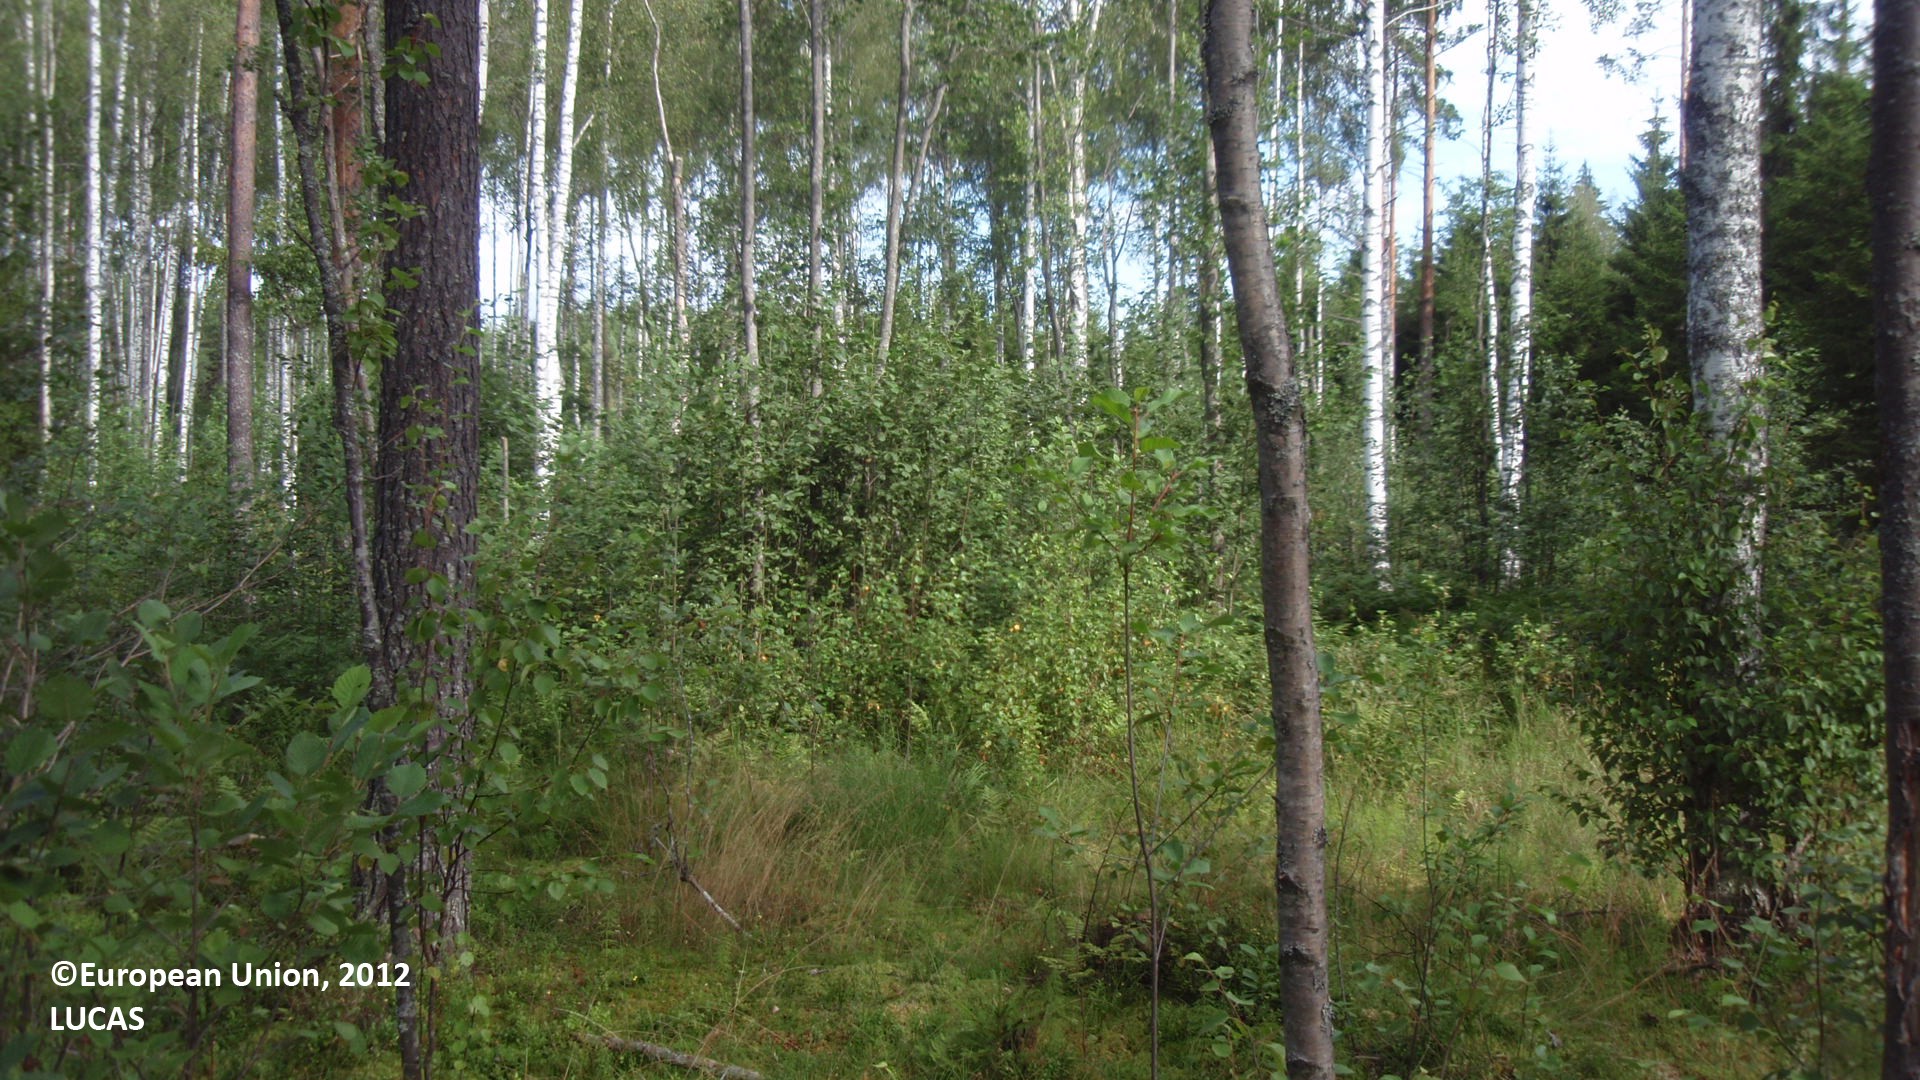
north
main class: Woodland
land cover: Broadleaved woodland
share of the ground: 25 - 50 %
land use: Forestry
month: August
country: FI
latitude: 61.2797
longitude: 27.7806
